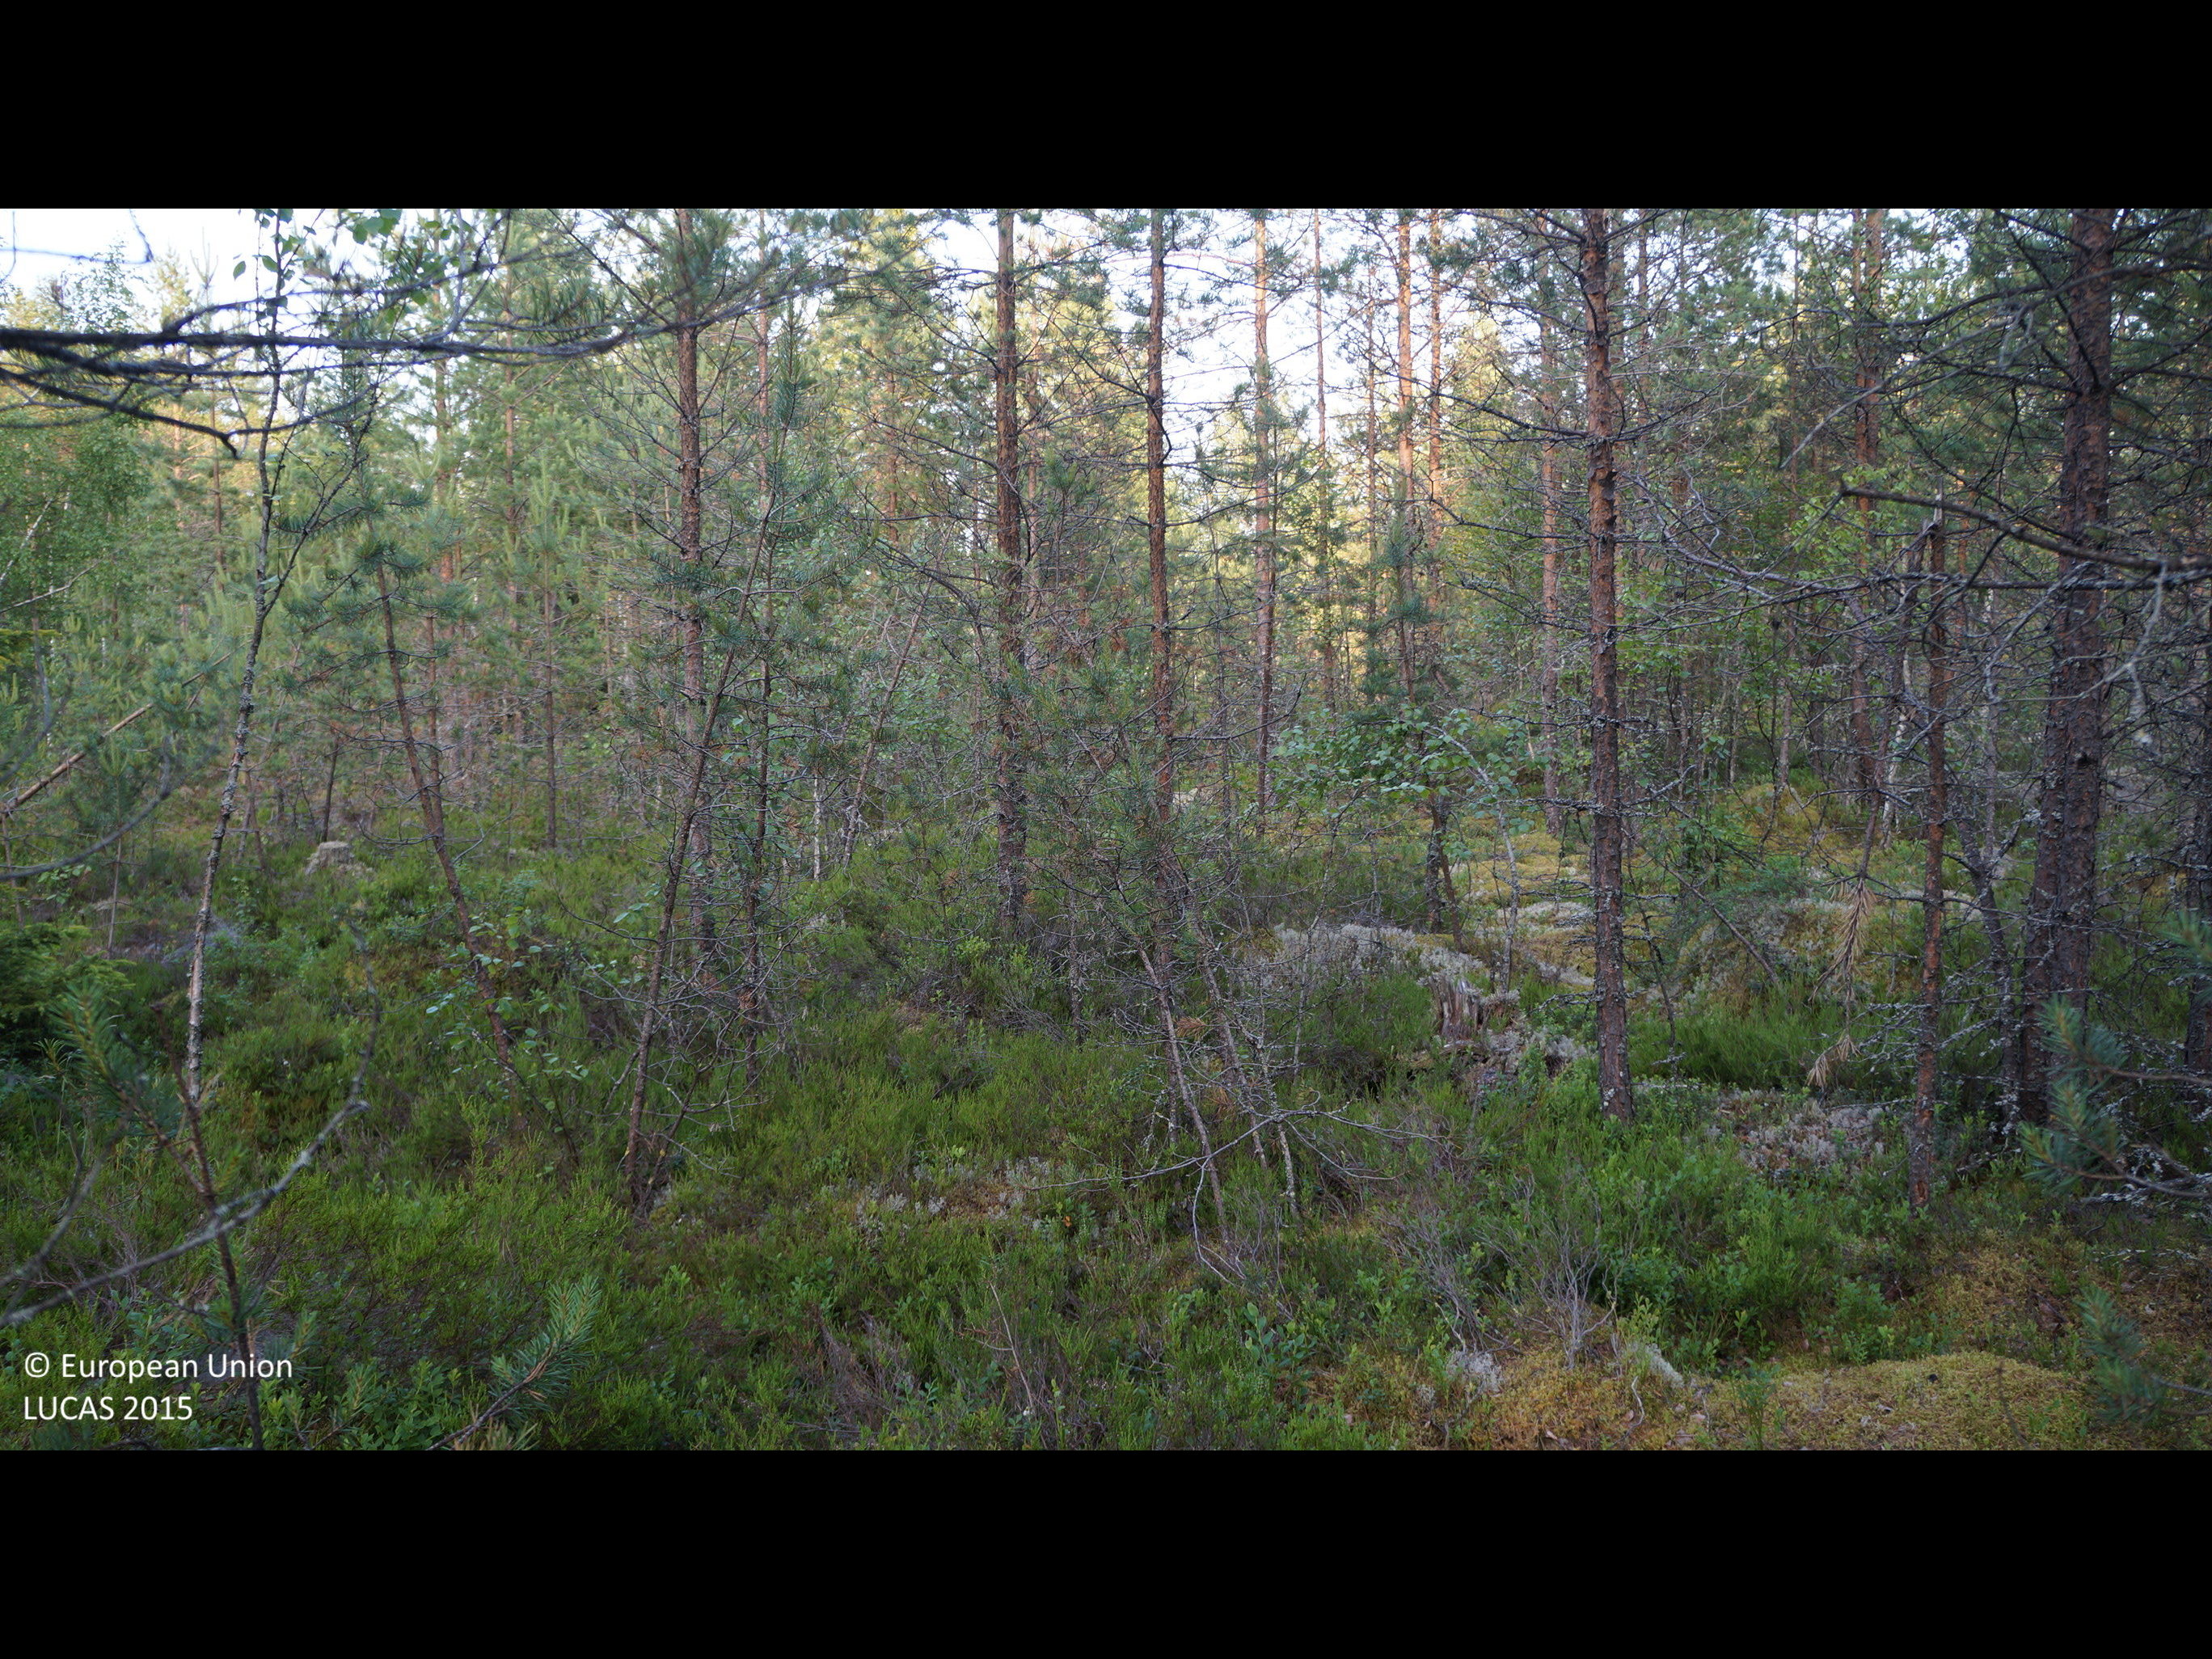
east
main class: Woodland
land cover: Pine dominated mixed woodland
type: boreal forest
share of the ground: 50 - 75 %
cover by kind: shrubs 40 %, coniferous forest trees 35 %, broadleaved forest trees 15 %, lichens and mosses 10 %
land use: Forestry
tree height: > 5 m
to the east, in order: Pine dominated mixed woodland; Other mixed woodland; Pine dominated mixed woodland; Other mixed woodland; Pine dominated mixed woodland; Ditches and canals; Broadleaved woodland; Pine dominated mixed woodland
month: July
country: FI
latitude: 63.7734
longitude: 24.0014
